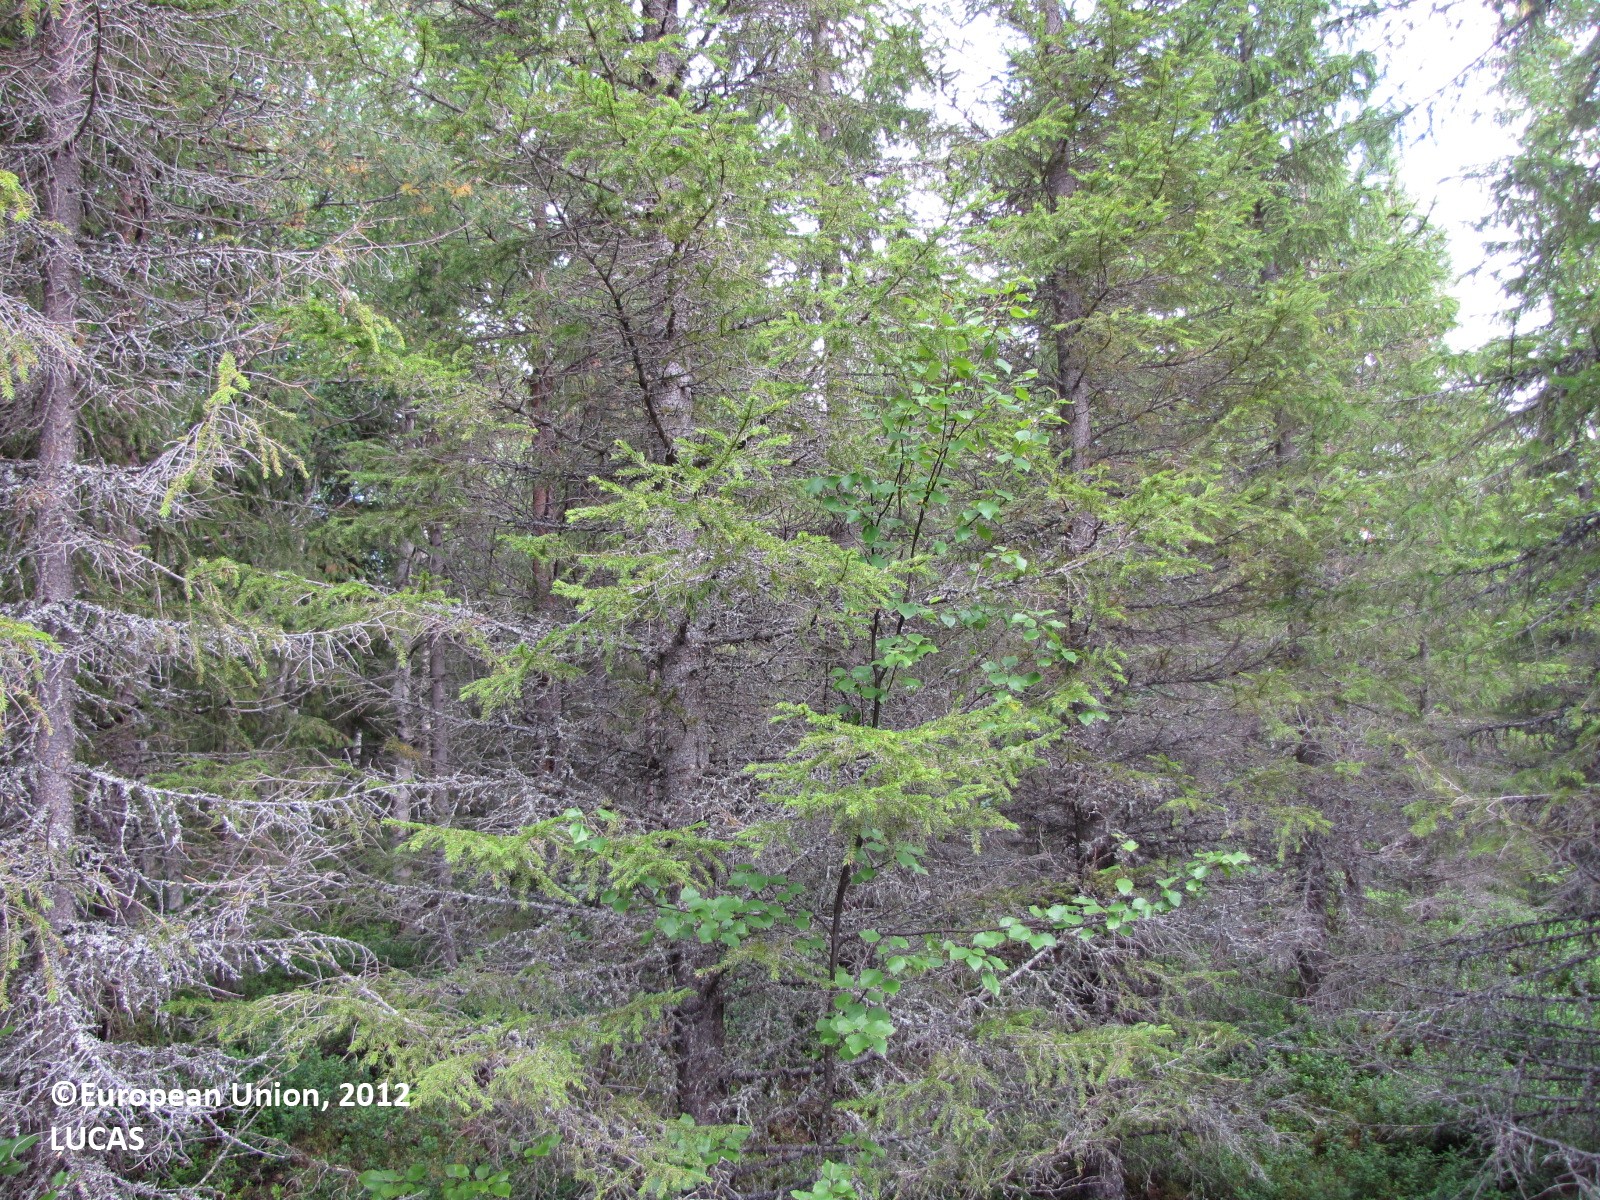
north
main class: Woodland
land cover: Spruce dominated coniferous woodland
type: boreal forest
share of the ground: 25 - 50 %
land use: Forestry
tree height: > 5 m
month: August
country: FI
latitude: 66.8385
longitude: 24.6005
